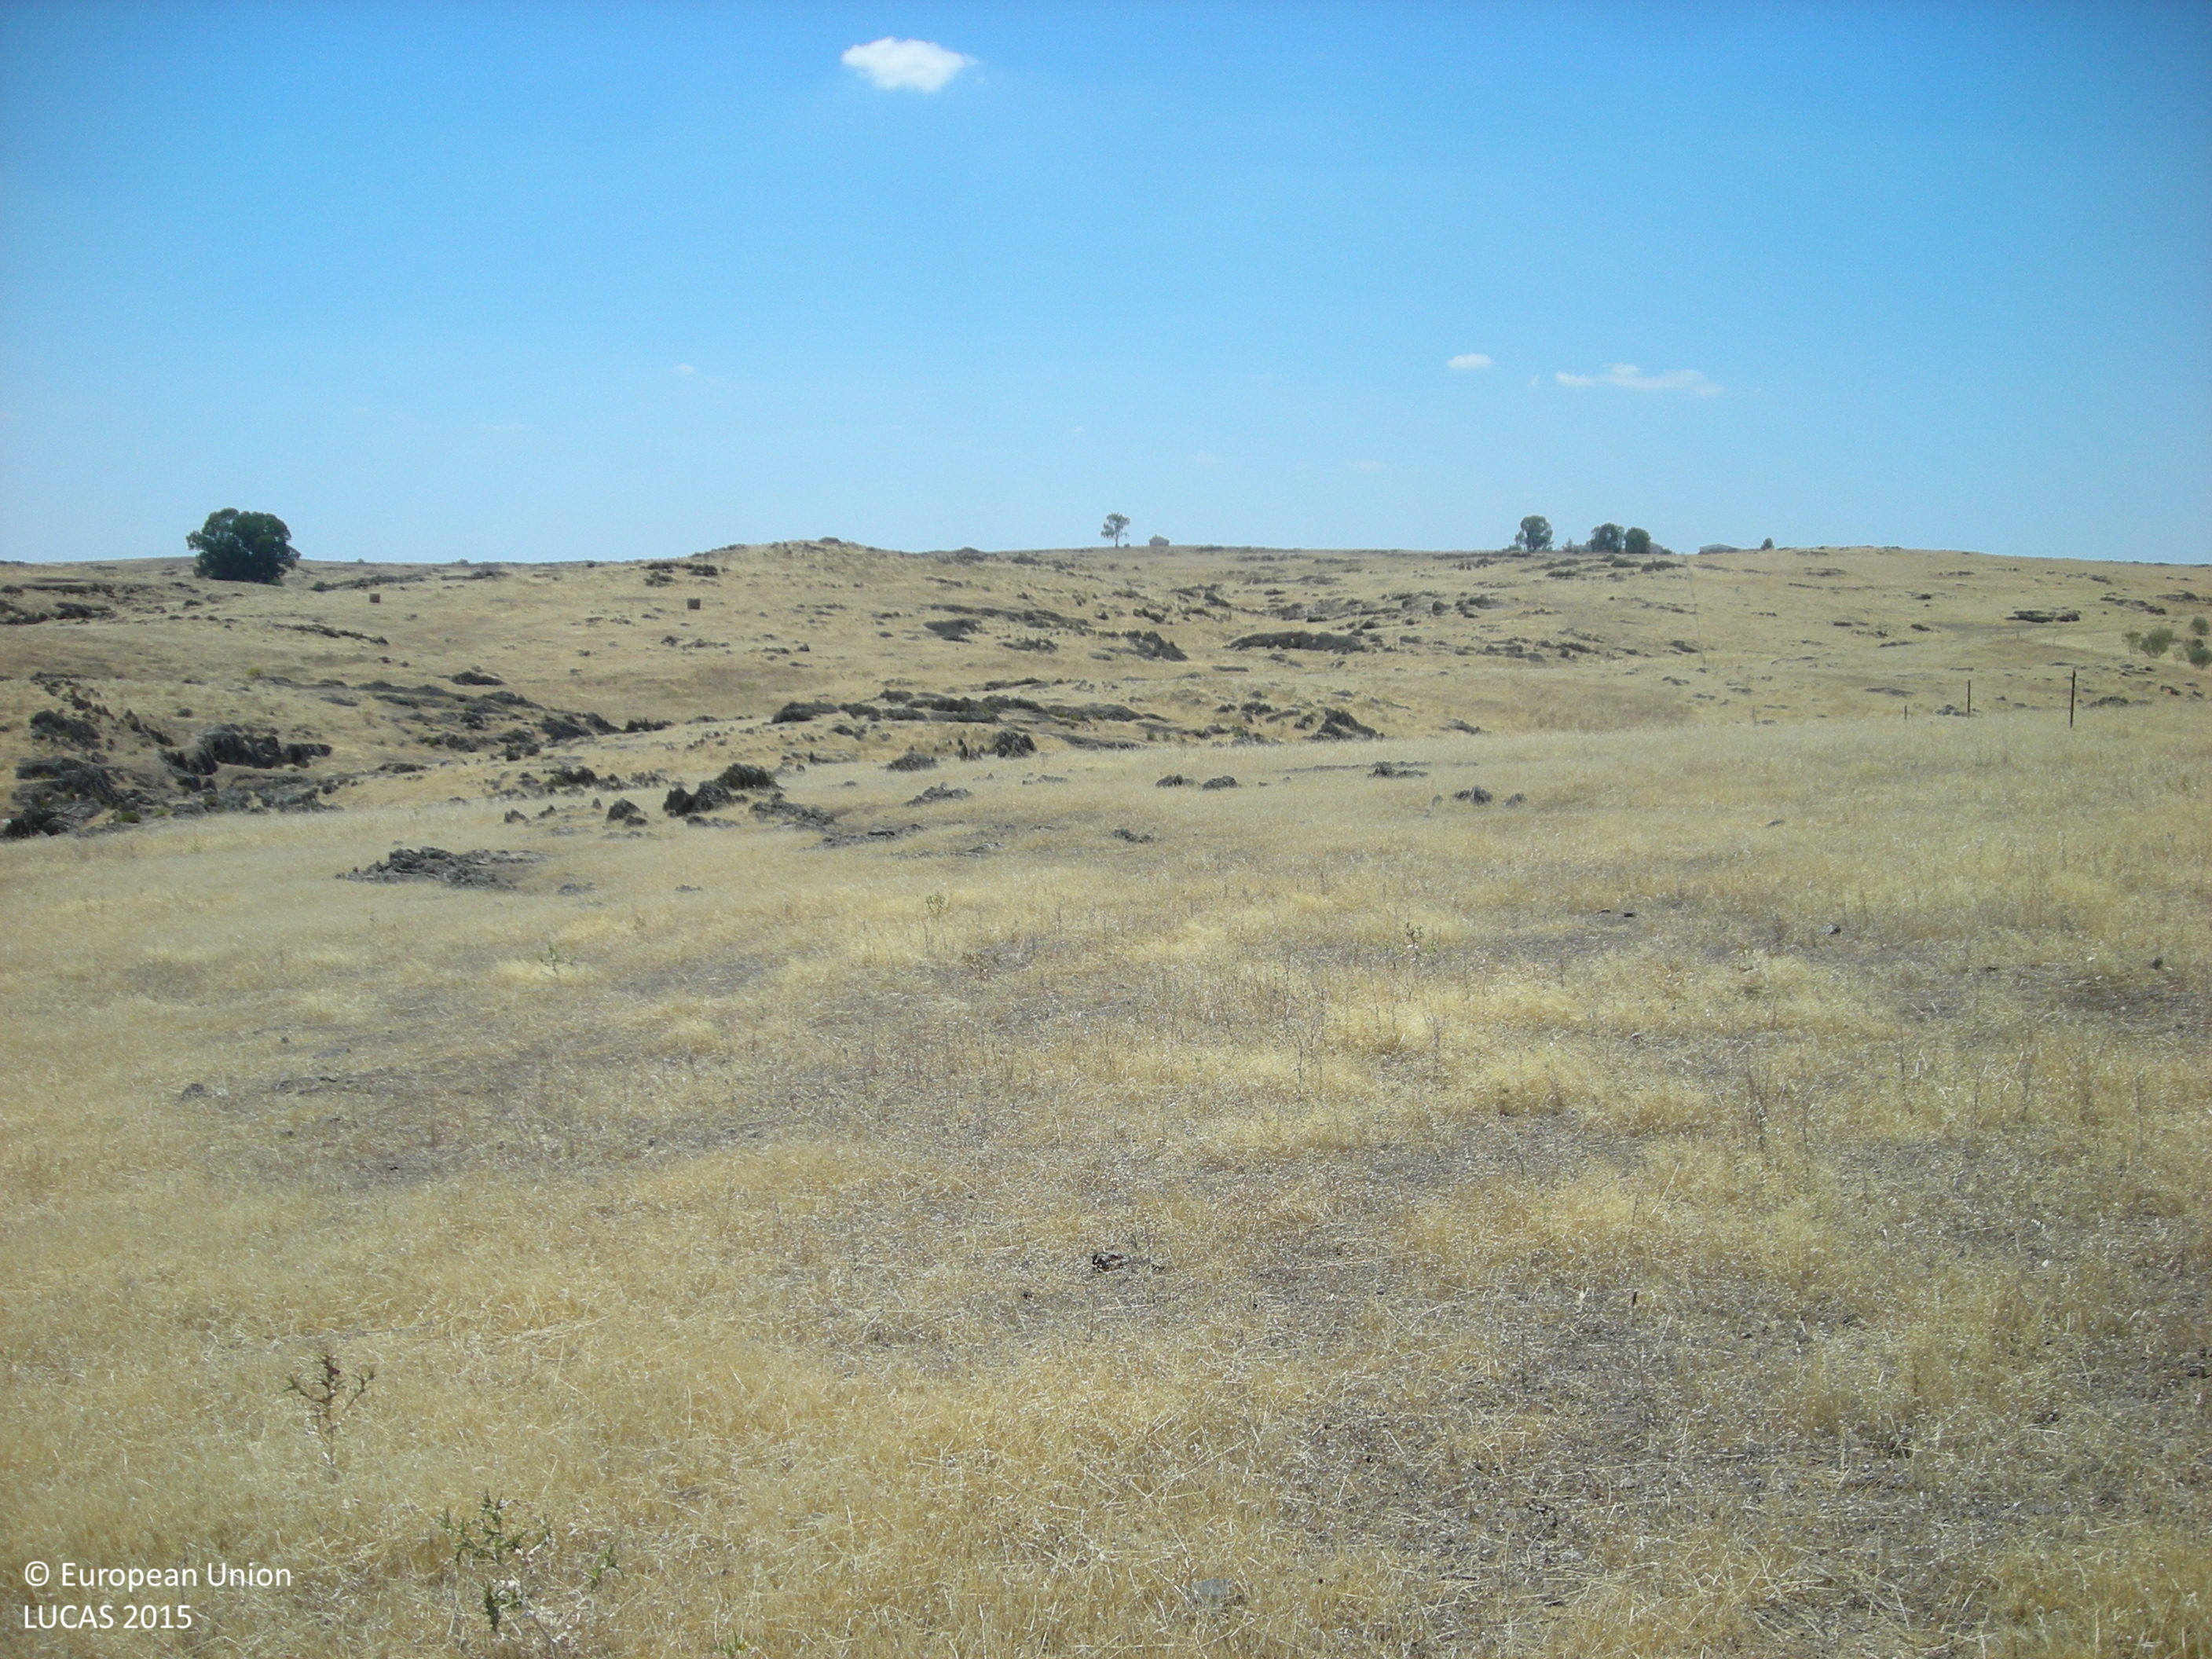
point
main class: Grassland
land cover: Grassland without tree/shrub cover
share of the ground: > 75 %
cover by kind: herbaceous plants 100 %
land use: Agriculture (excluding fallow land and kitchen gardens)
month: June
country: ES
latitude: 38.8696
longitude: -5.4505
